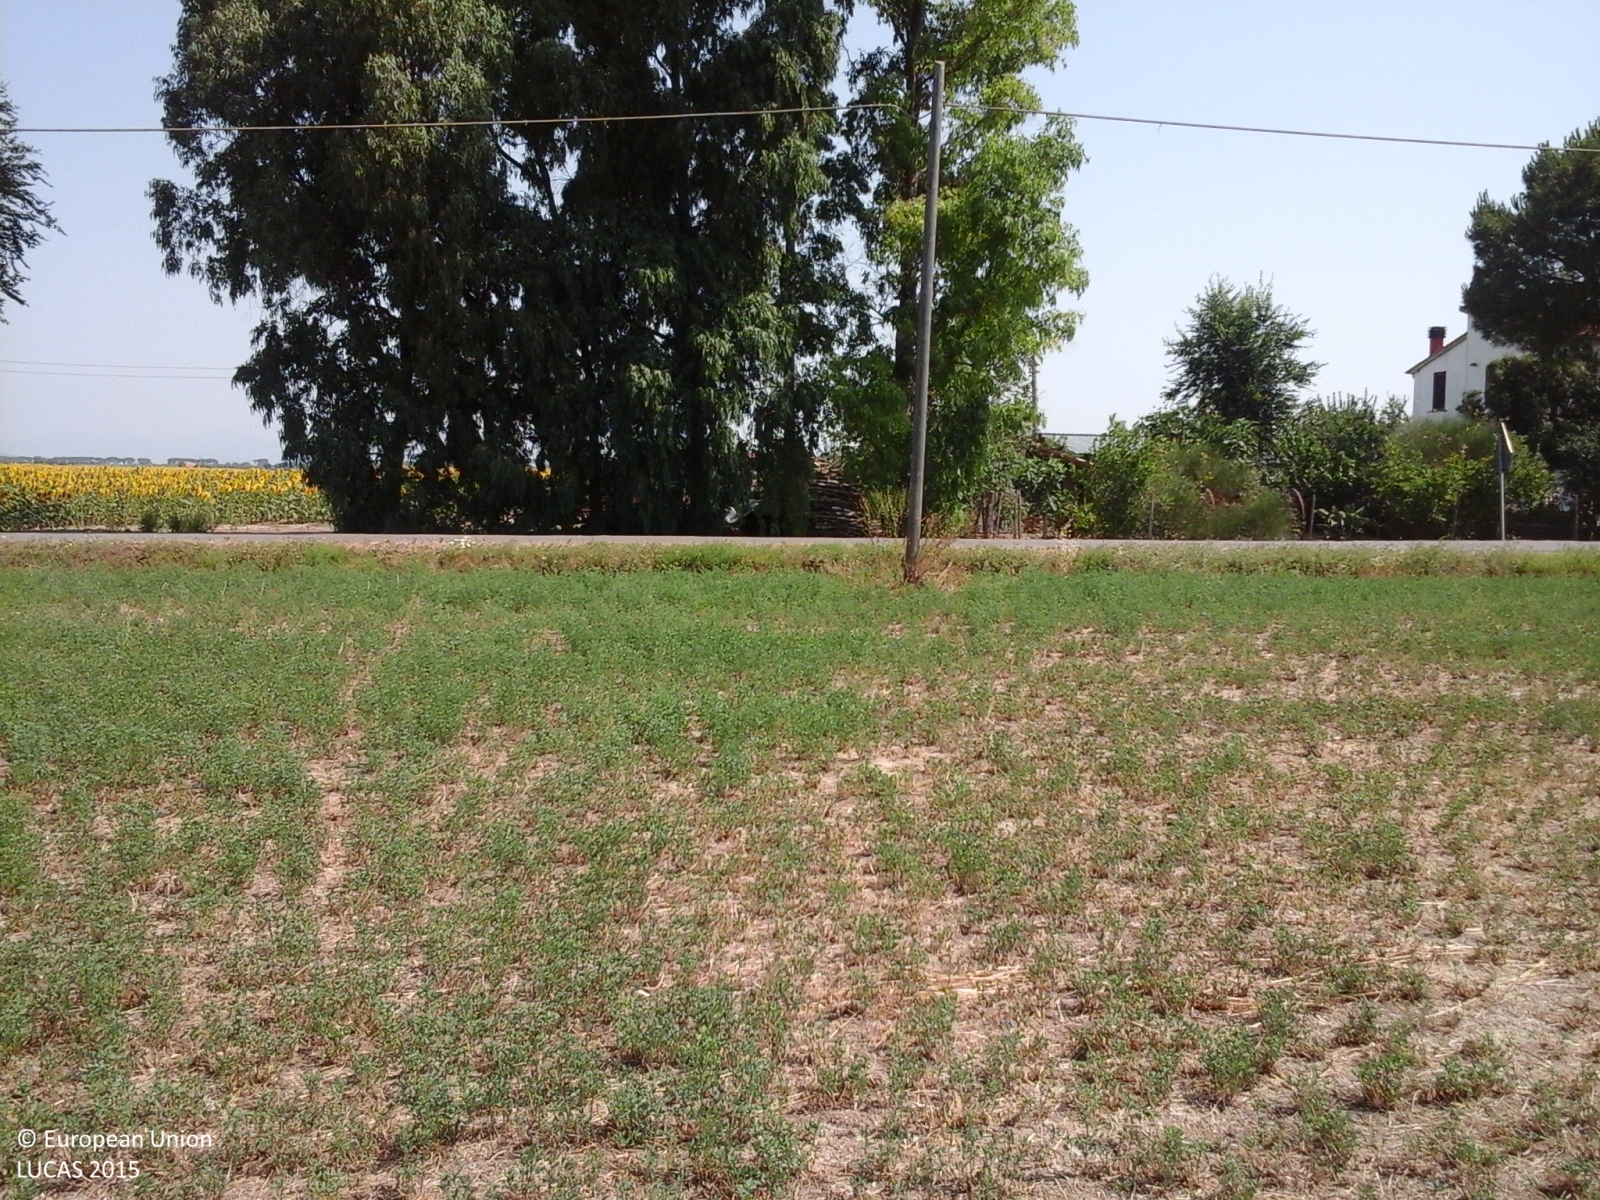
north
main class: Cropland
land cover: Lucerne
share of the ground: > 75 %
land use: Agriculture (excluding fallow land and kitchen gardens)
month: July
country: IT
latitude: 42.7571
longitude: 11.0352
